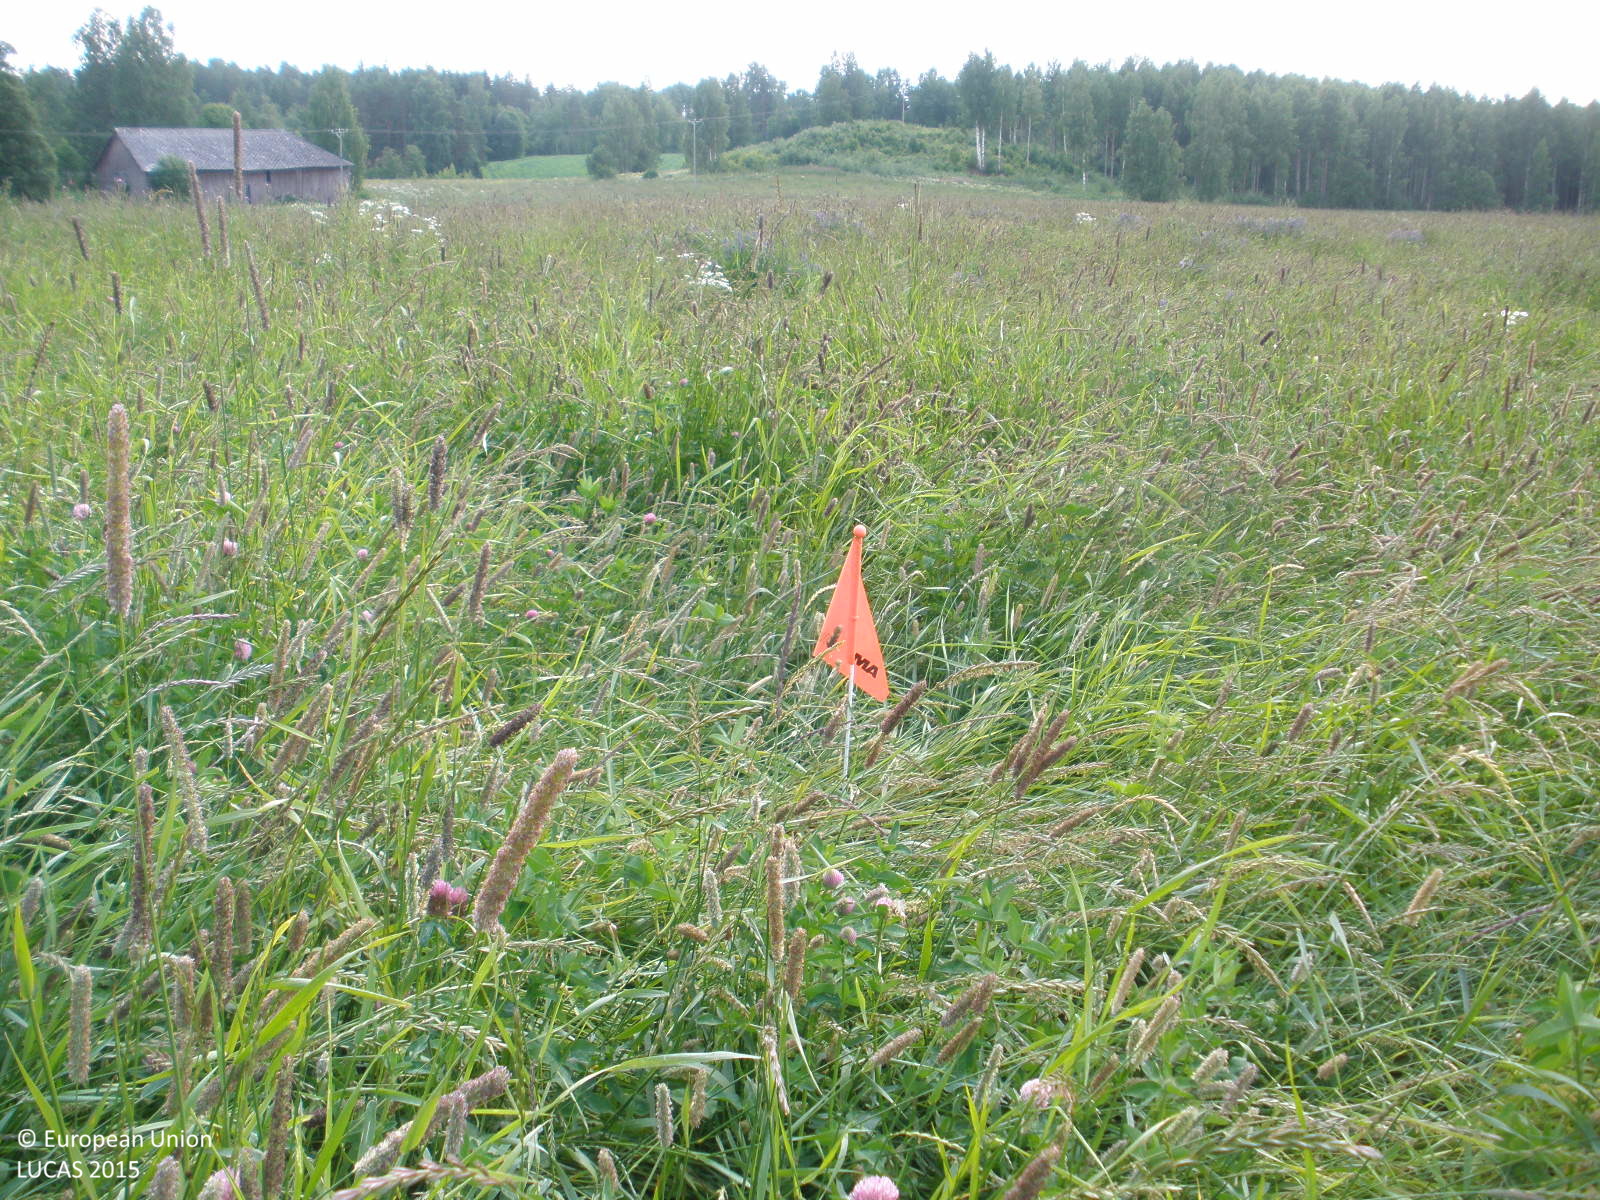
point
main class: Cropland
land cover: Temporary grasslands
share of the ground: > 75 %
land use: Agriculture (excluding fallow land and kitchen gardens)
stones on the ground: < 10 %
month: July
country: FI
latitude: 61.3945
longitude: 24.4594
